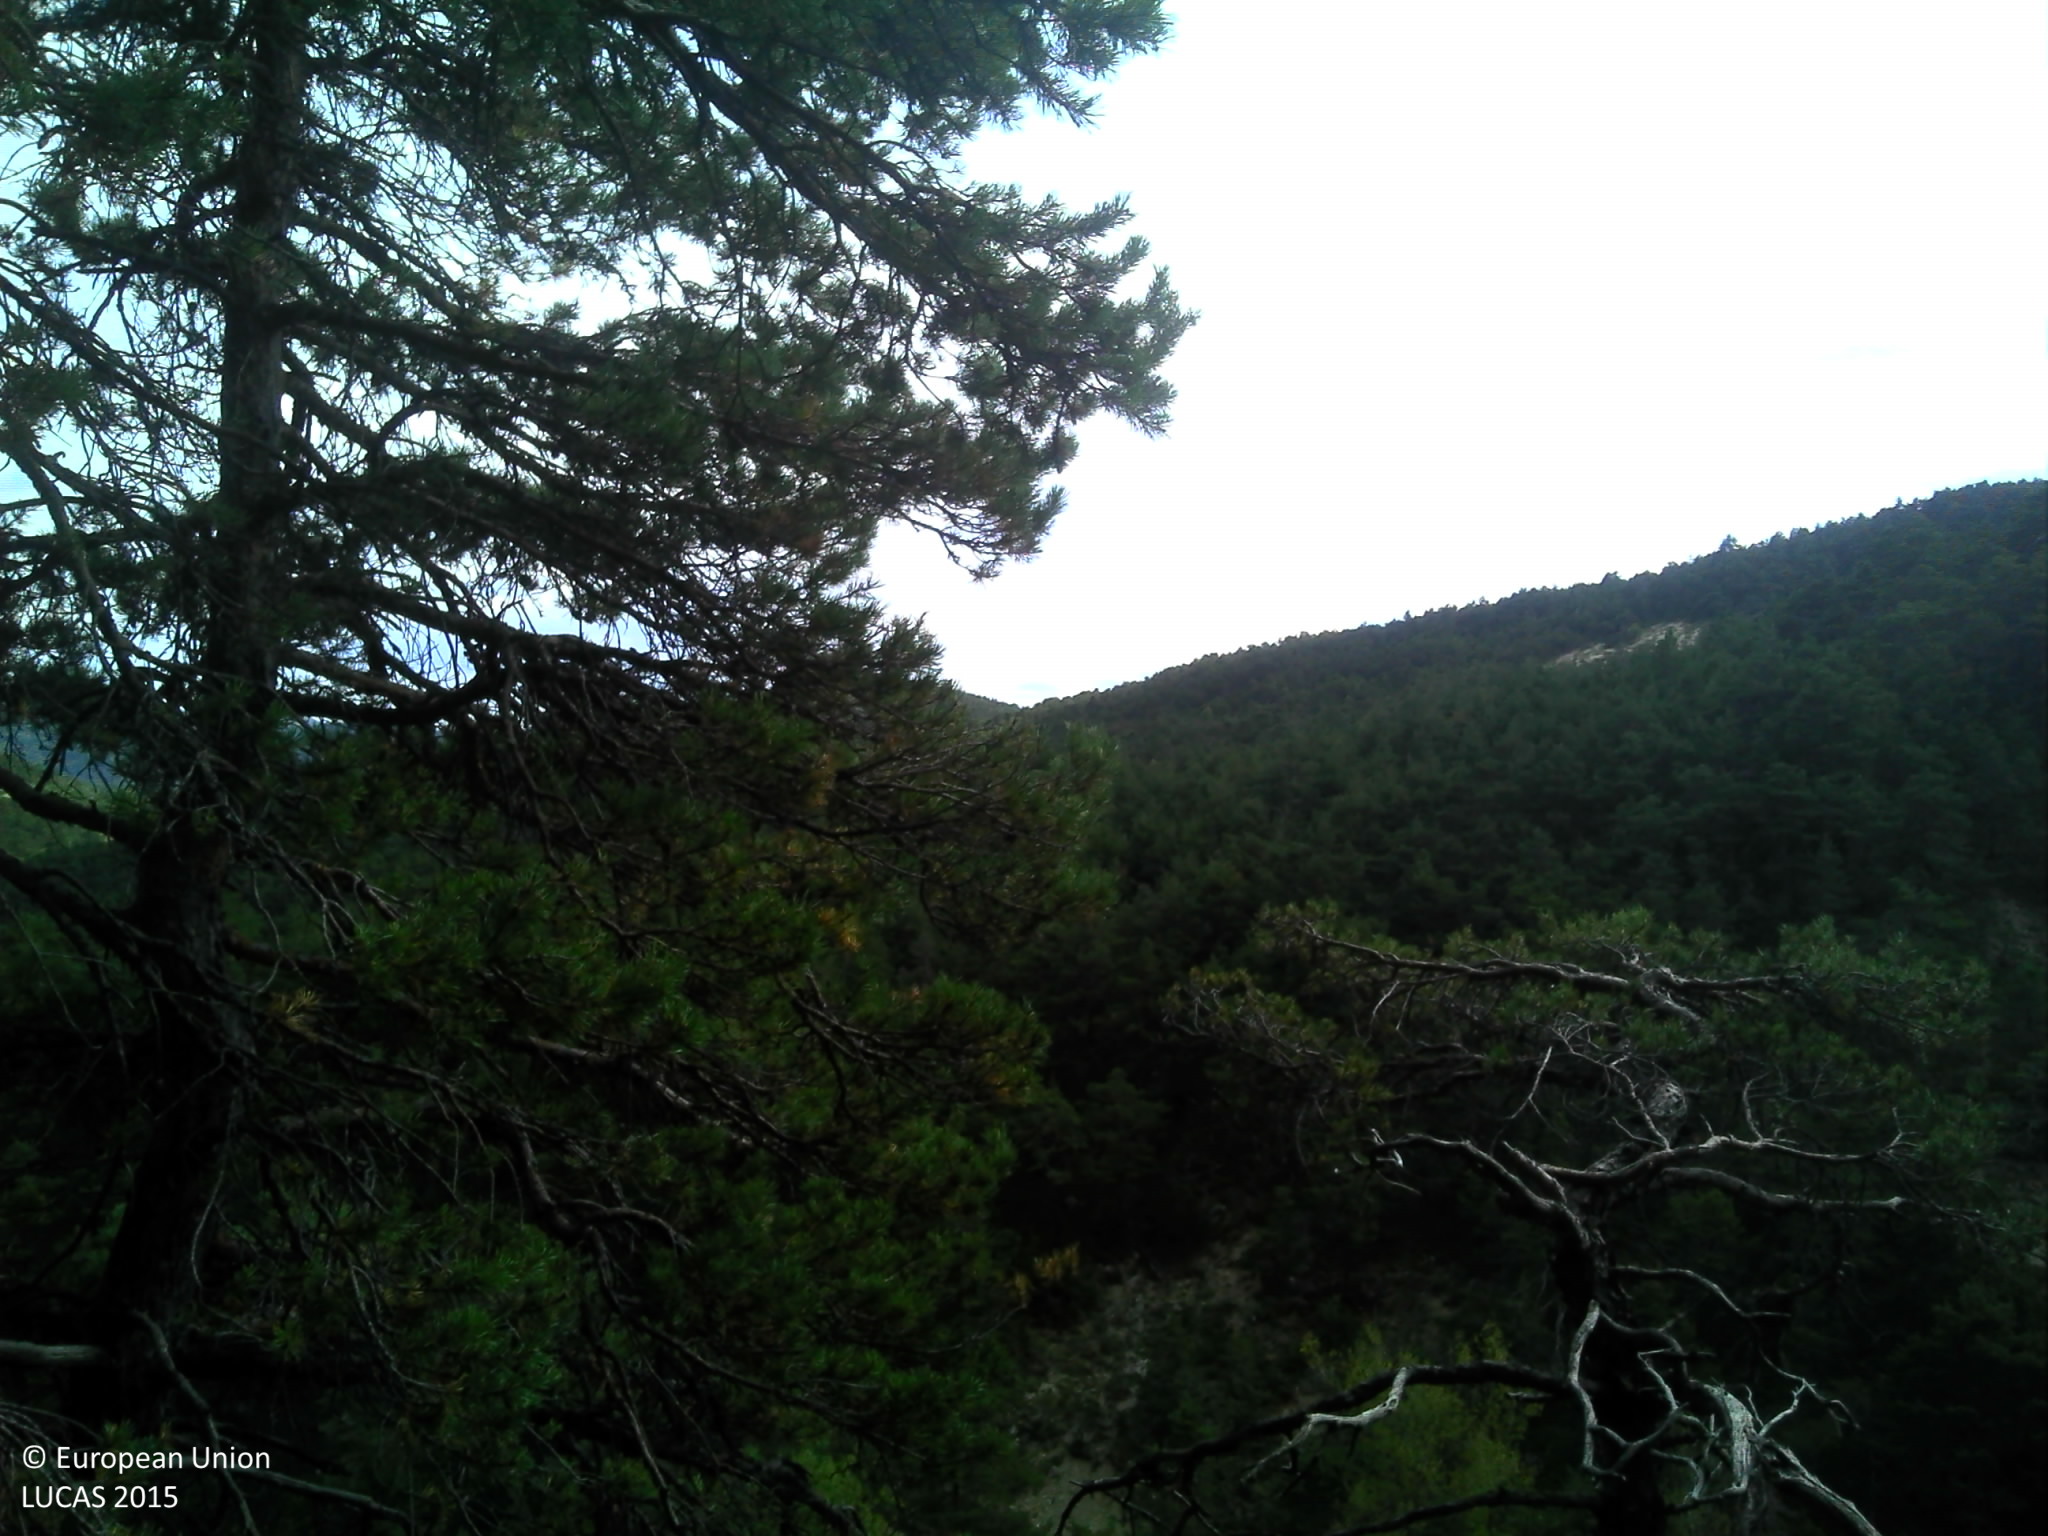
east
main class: Woodland
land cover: Pine dominated coniferous woodland
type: coniferous forest of the mediterranean region
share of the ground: > 75 %
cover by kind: coniferous forest trees 65 %, herbaceous plants 30 %, broadleaved forest trees 5 %
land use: Semi-natural and natural areas not in use
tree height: > 5 m
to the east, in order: Pine dominated coniferous woodland; Tracks; Shrubland with sparse tree cover; Tracks; Pine dominated coniferous woodland; Rivers and streams; Pine dominated coniferous woodland; Tracks; Pine dominated coniferous woodland; Rivers and streams; Broadleaved woodland
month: September
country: FR
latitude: 44.5382
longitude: 5.4133
